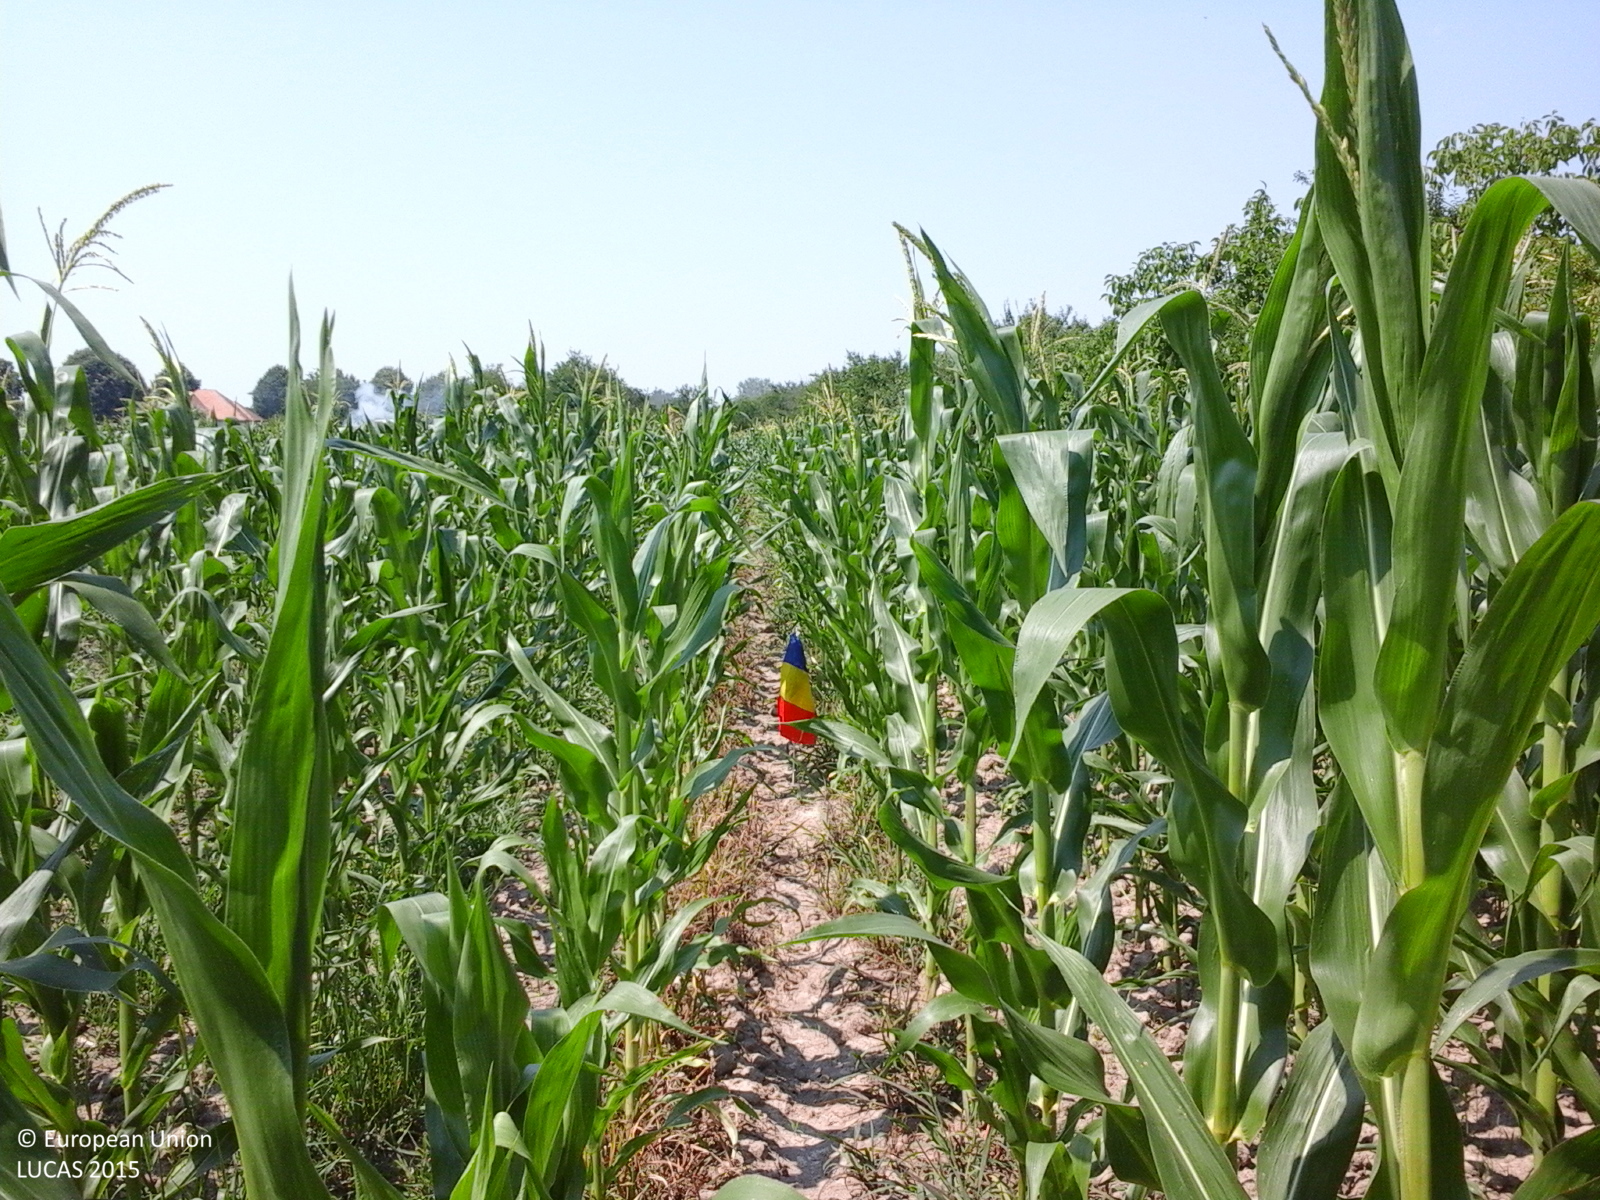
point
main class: Cropland
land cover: Maize
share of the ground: > 75 %
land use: Agriculture (excluding fallow land and kitchen gardens)
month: July
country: RO
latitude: 44.7469
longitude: 25.6713
